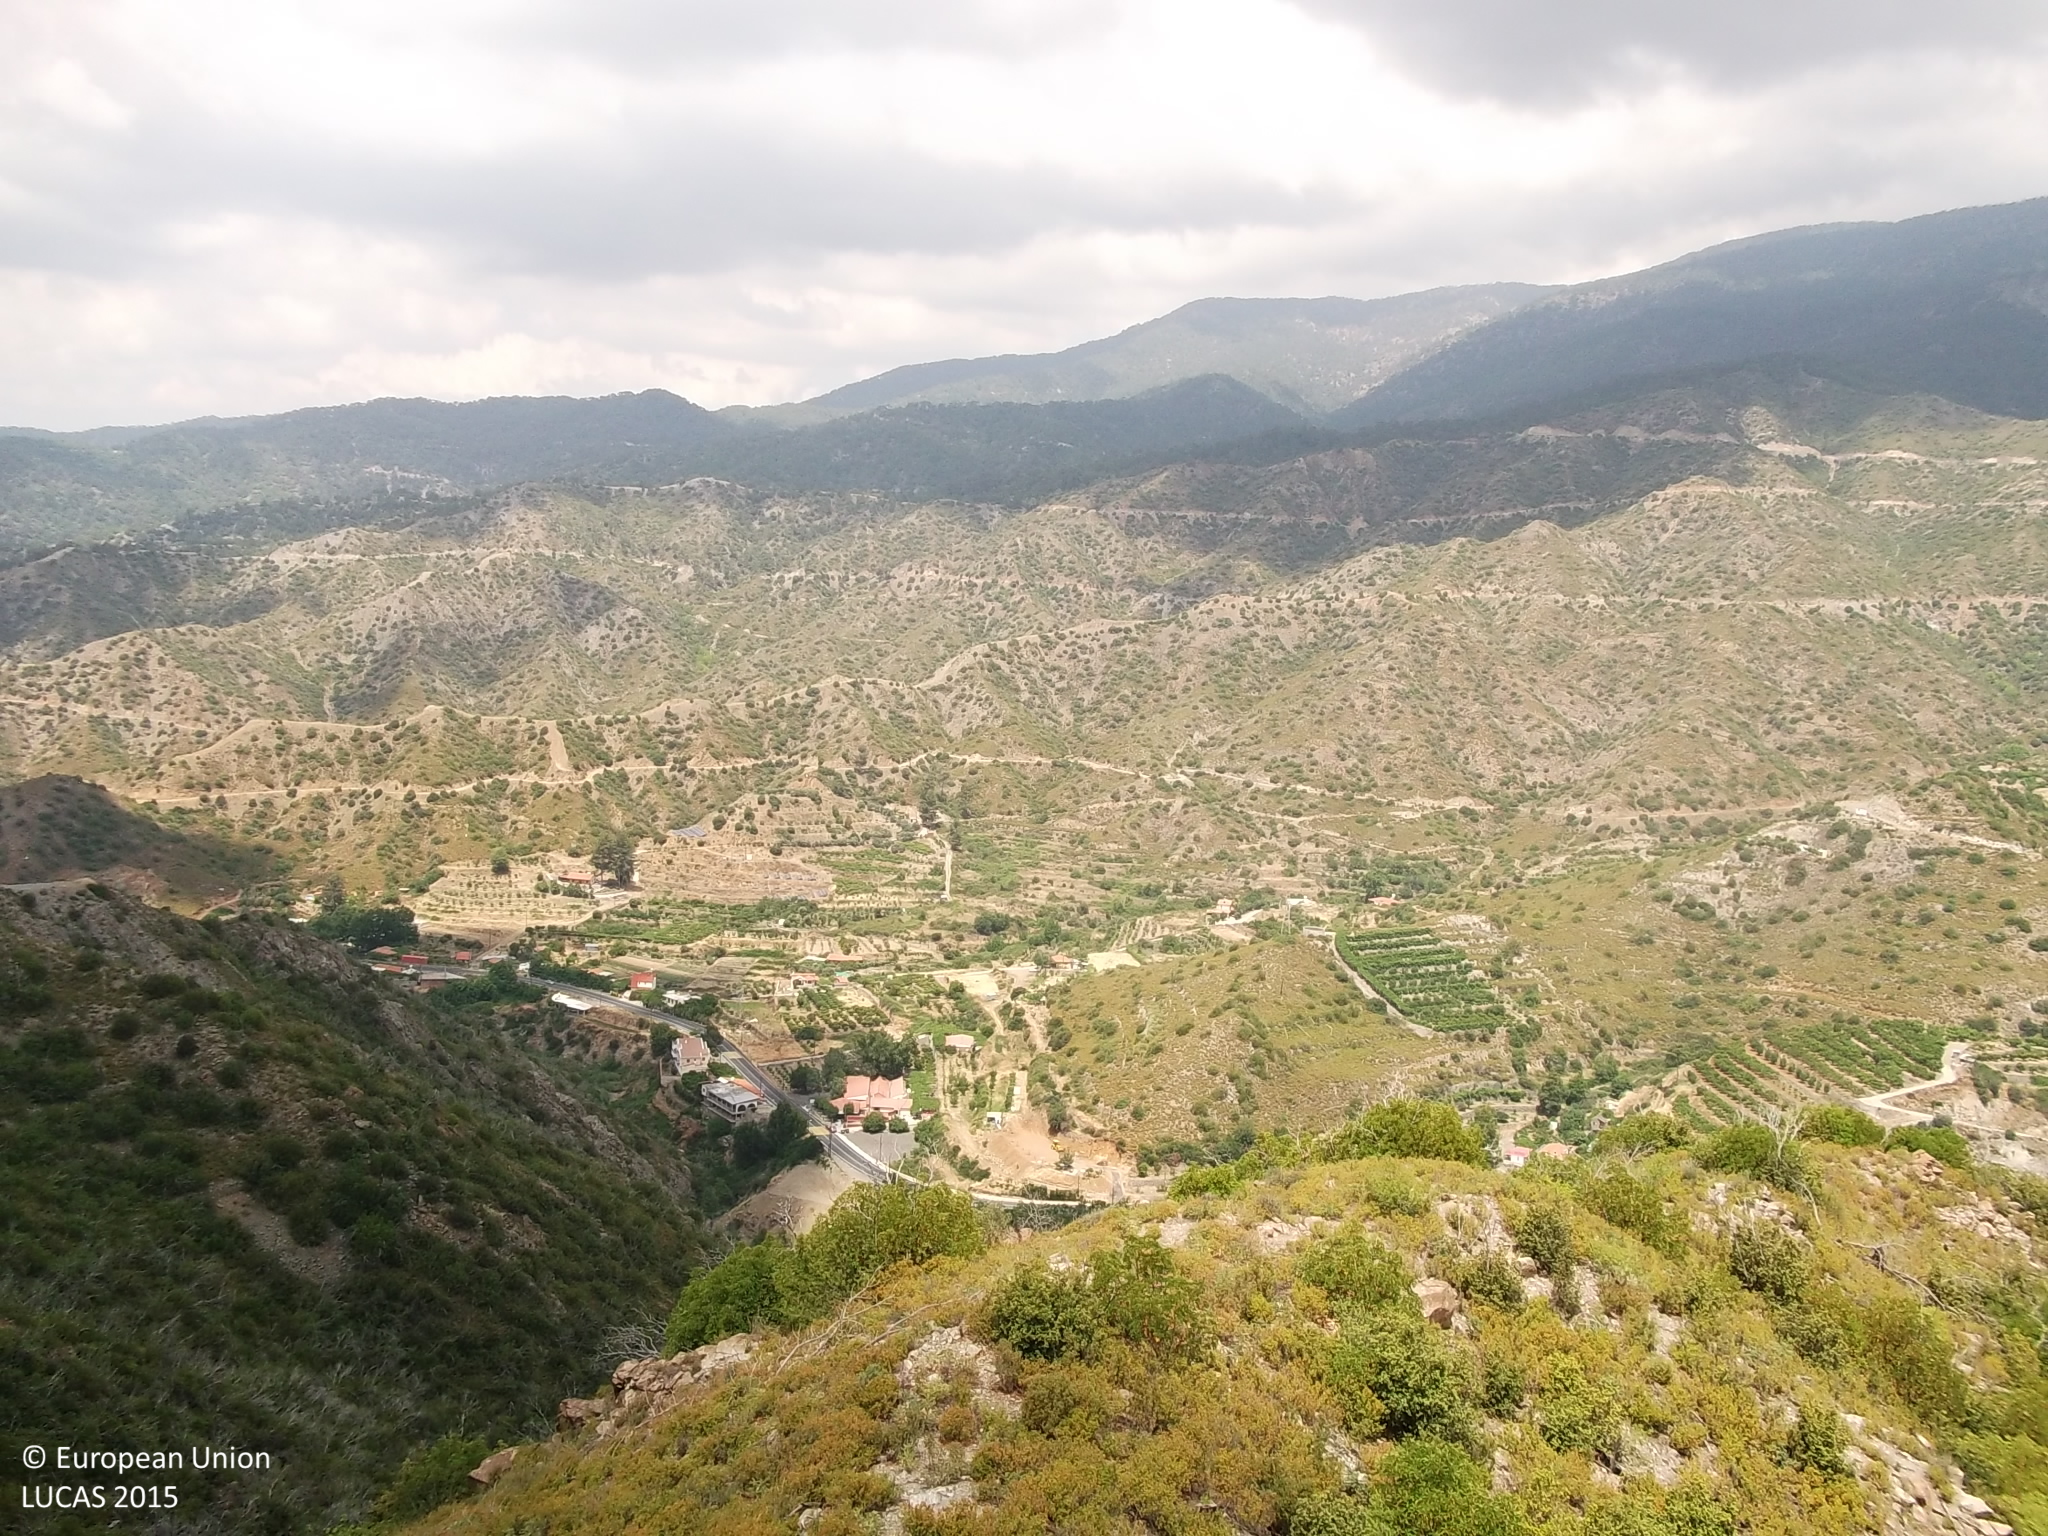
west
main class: Shrubland
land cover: Shrubland with sparse tree cover
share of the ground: > 75 %
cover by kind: shrubs 80 %, consolidated bare surface 10 %, broadleaved forest trees 5 %, unconsolidated bare surface 5 %
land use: Semi-natural and natural areas not in use
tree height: < 5 m
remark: Burnt area
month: June
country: CY
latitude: 34.8851
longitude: 32.9368
